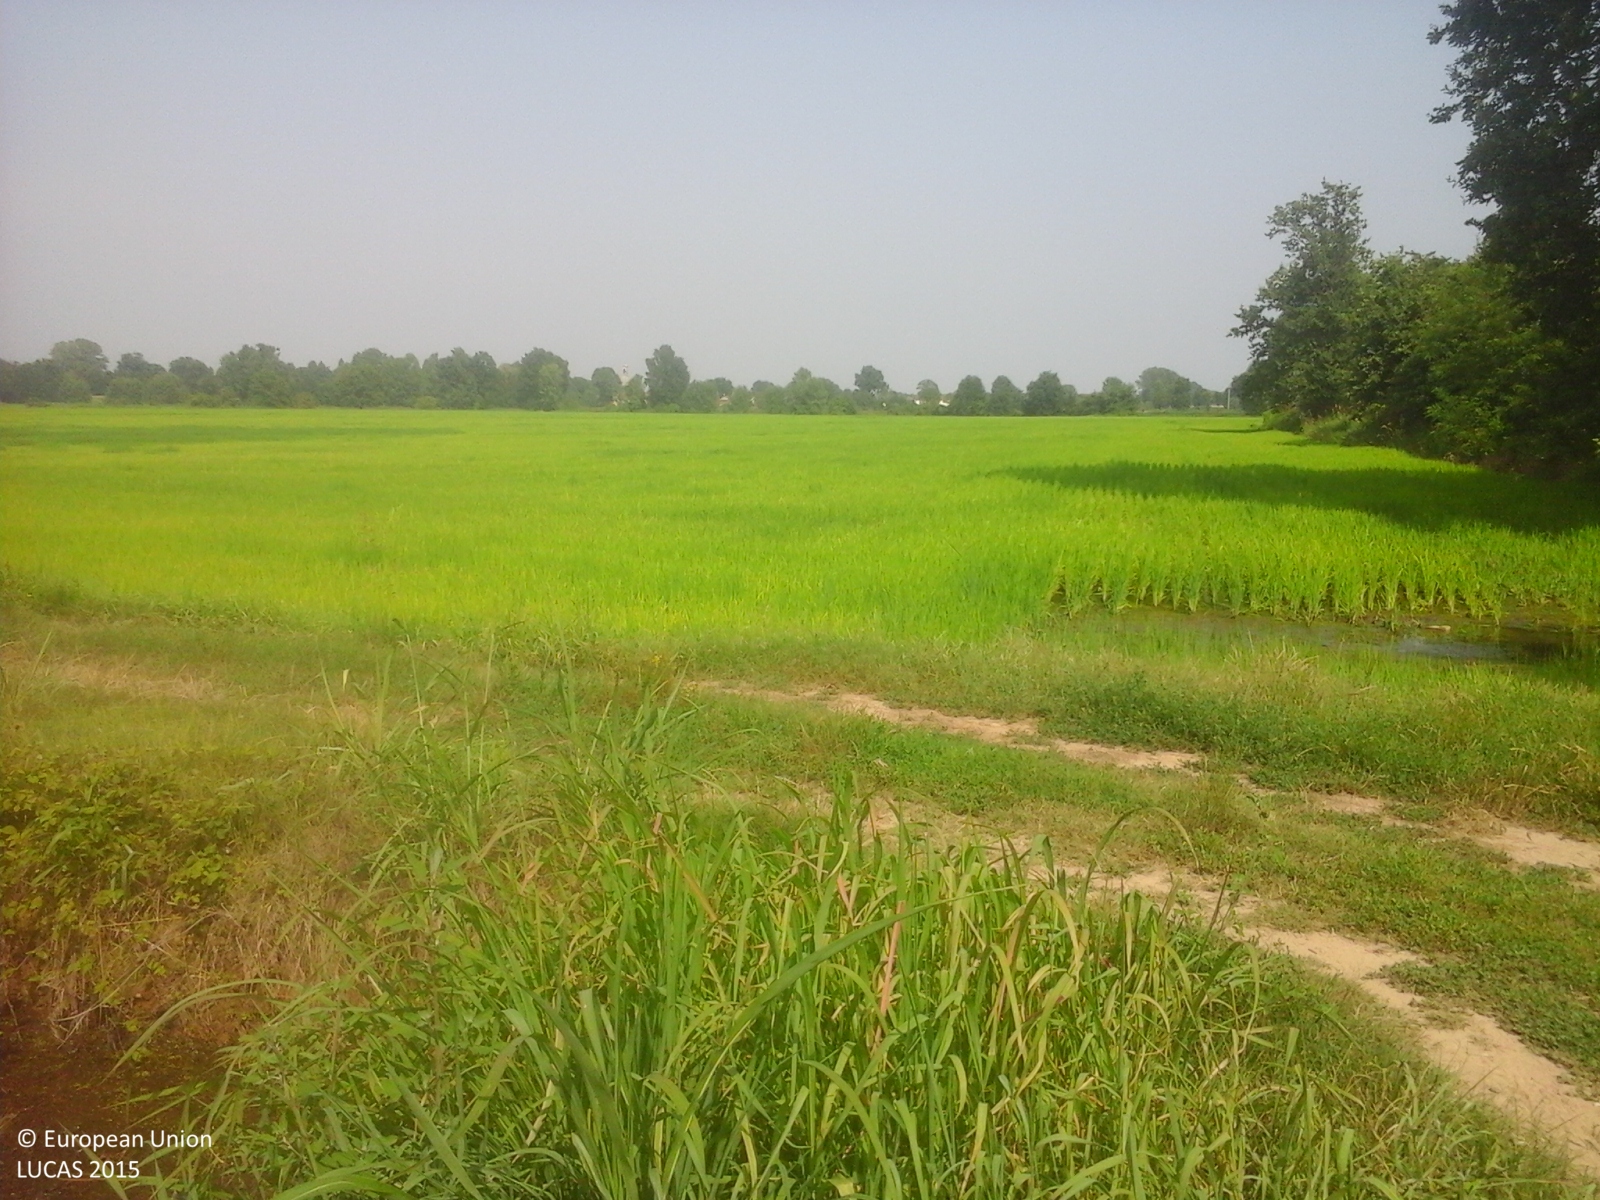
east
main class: Cropland
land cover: Rice
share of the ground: > 75 %
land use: Agriculture (excluding fallow land and kitchen gardens)
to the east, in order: Rice; Grass margins; Ditches and canals; Grass margins; Tracks; Grass margins; Rice; Grass margins; Ditches and canals; Grass margins; Rice
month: July
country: IT
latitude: 45.1776
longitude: 9.3014
